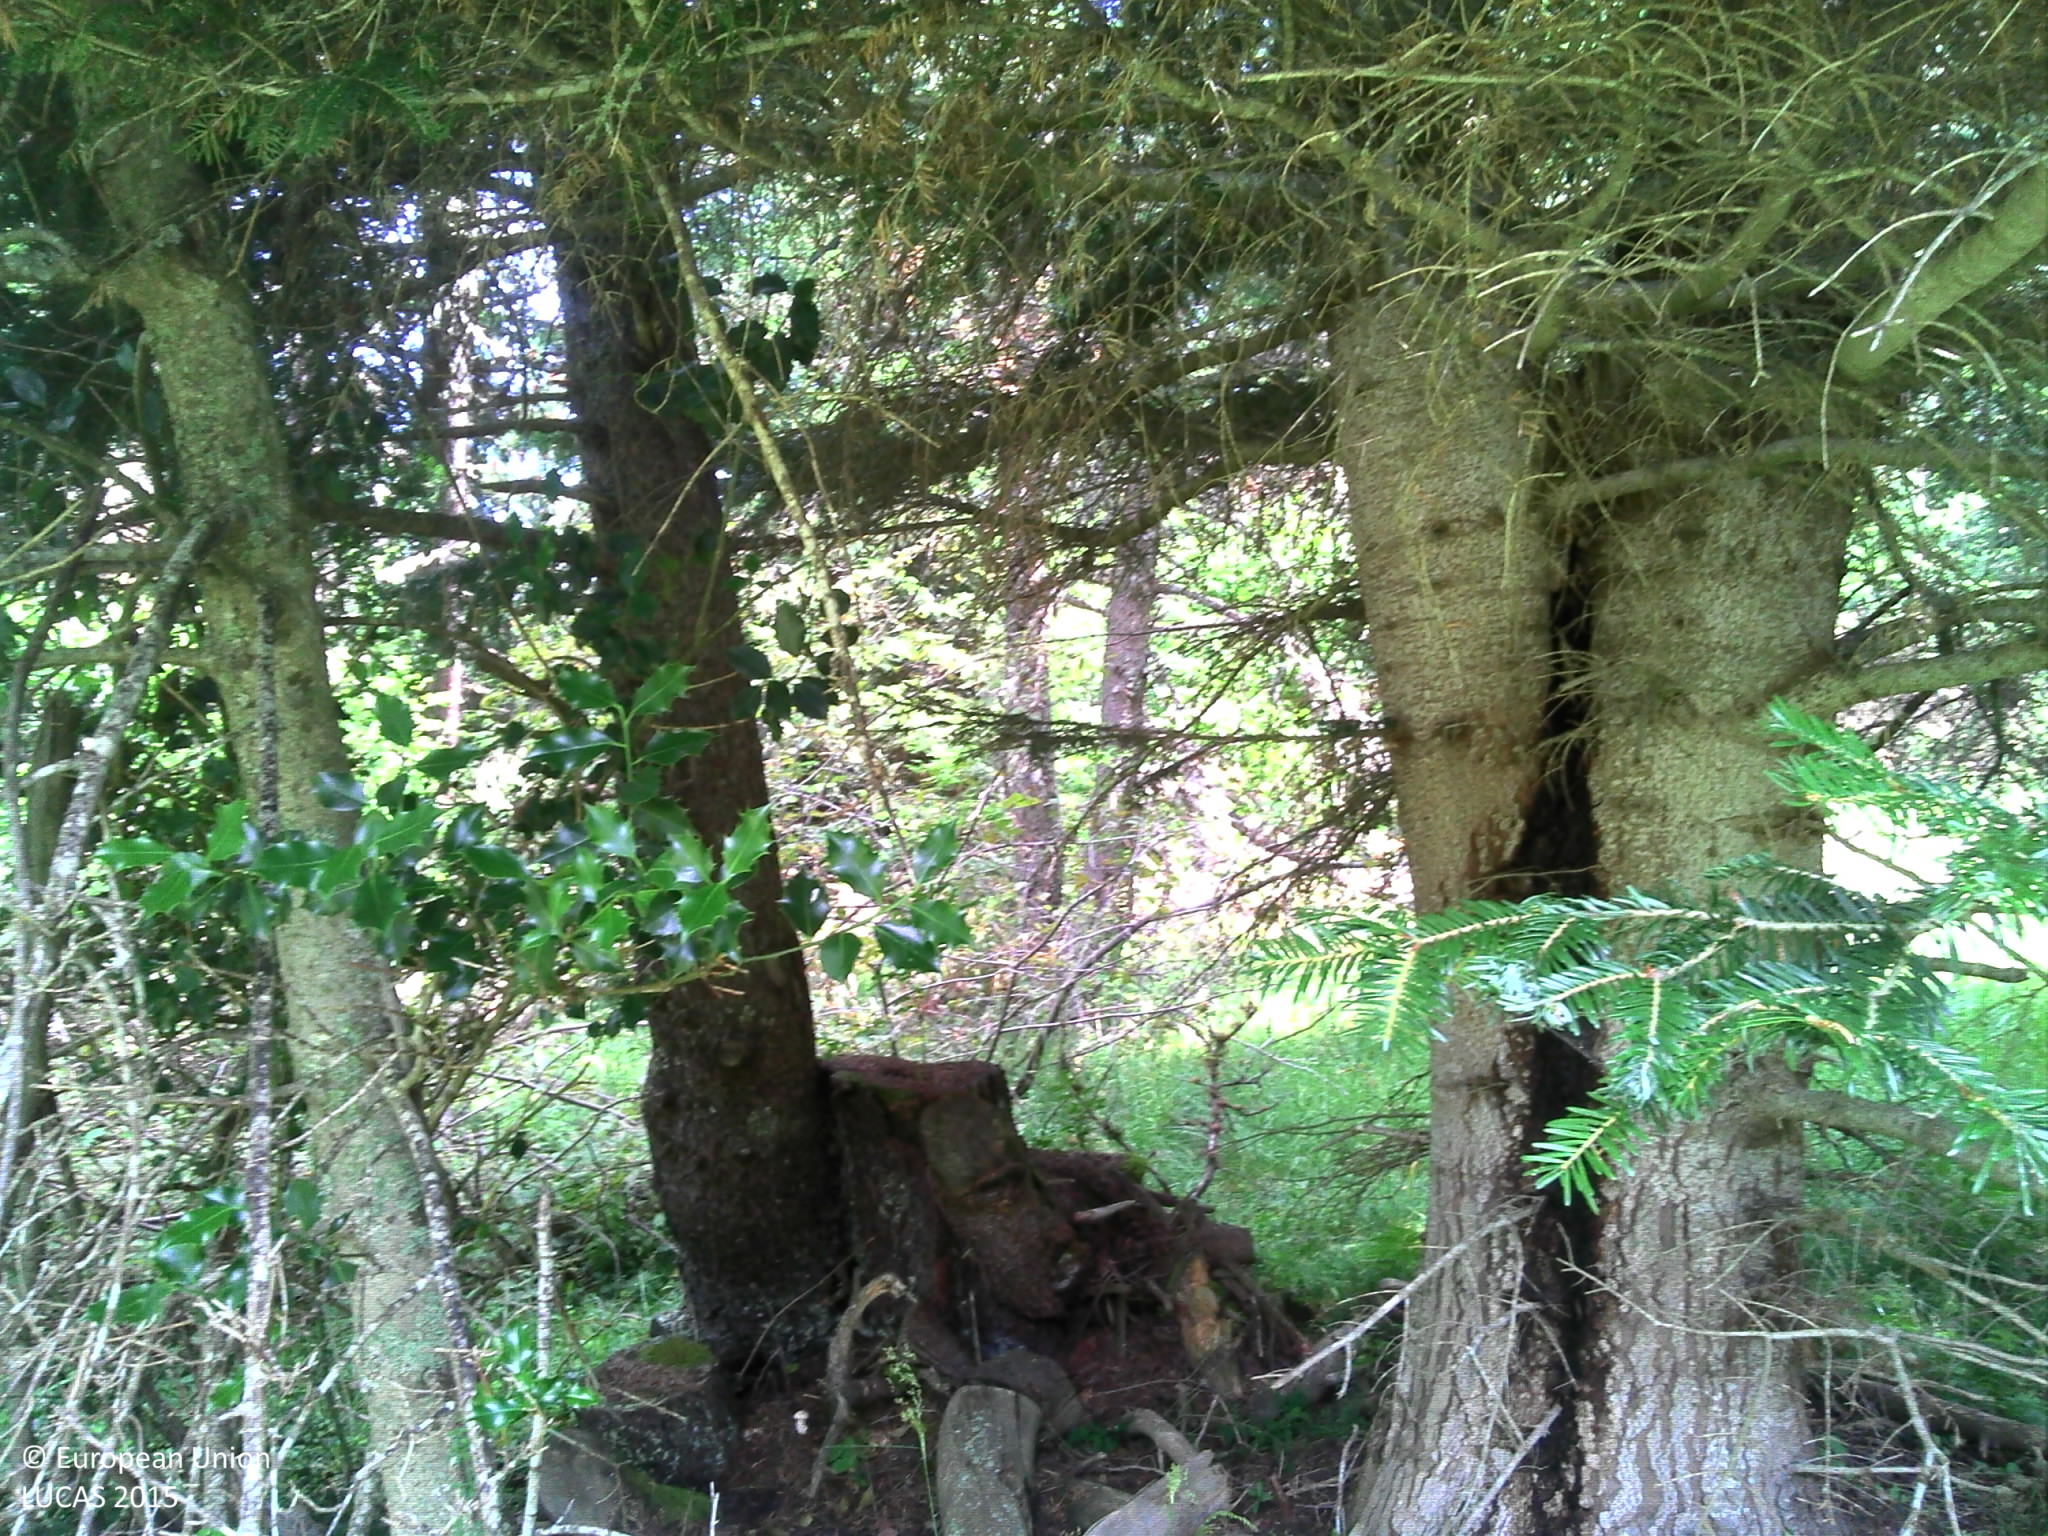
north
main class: Woodland
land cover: Other mixed woodland
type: alpine coniferous forest
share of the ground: > 75 %
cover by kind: herbaceous plants 55 %, coniferous forest trees 30 %, broadleaved forest trees 15 %
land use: Forestry
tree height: > 5 m
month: July
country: FR
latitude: 42.6567
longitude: 2.1421
